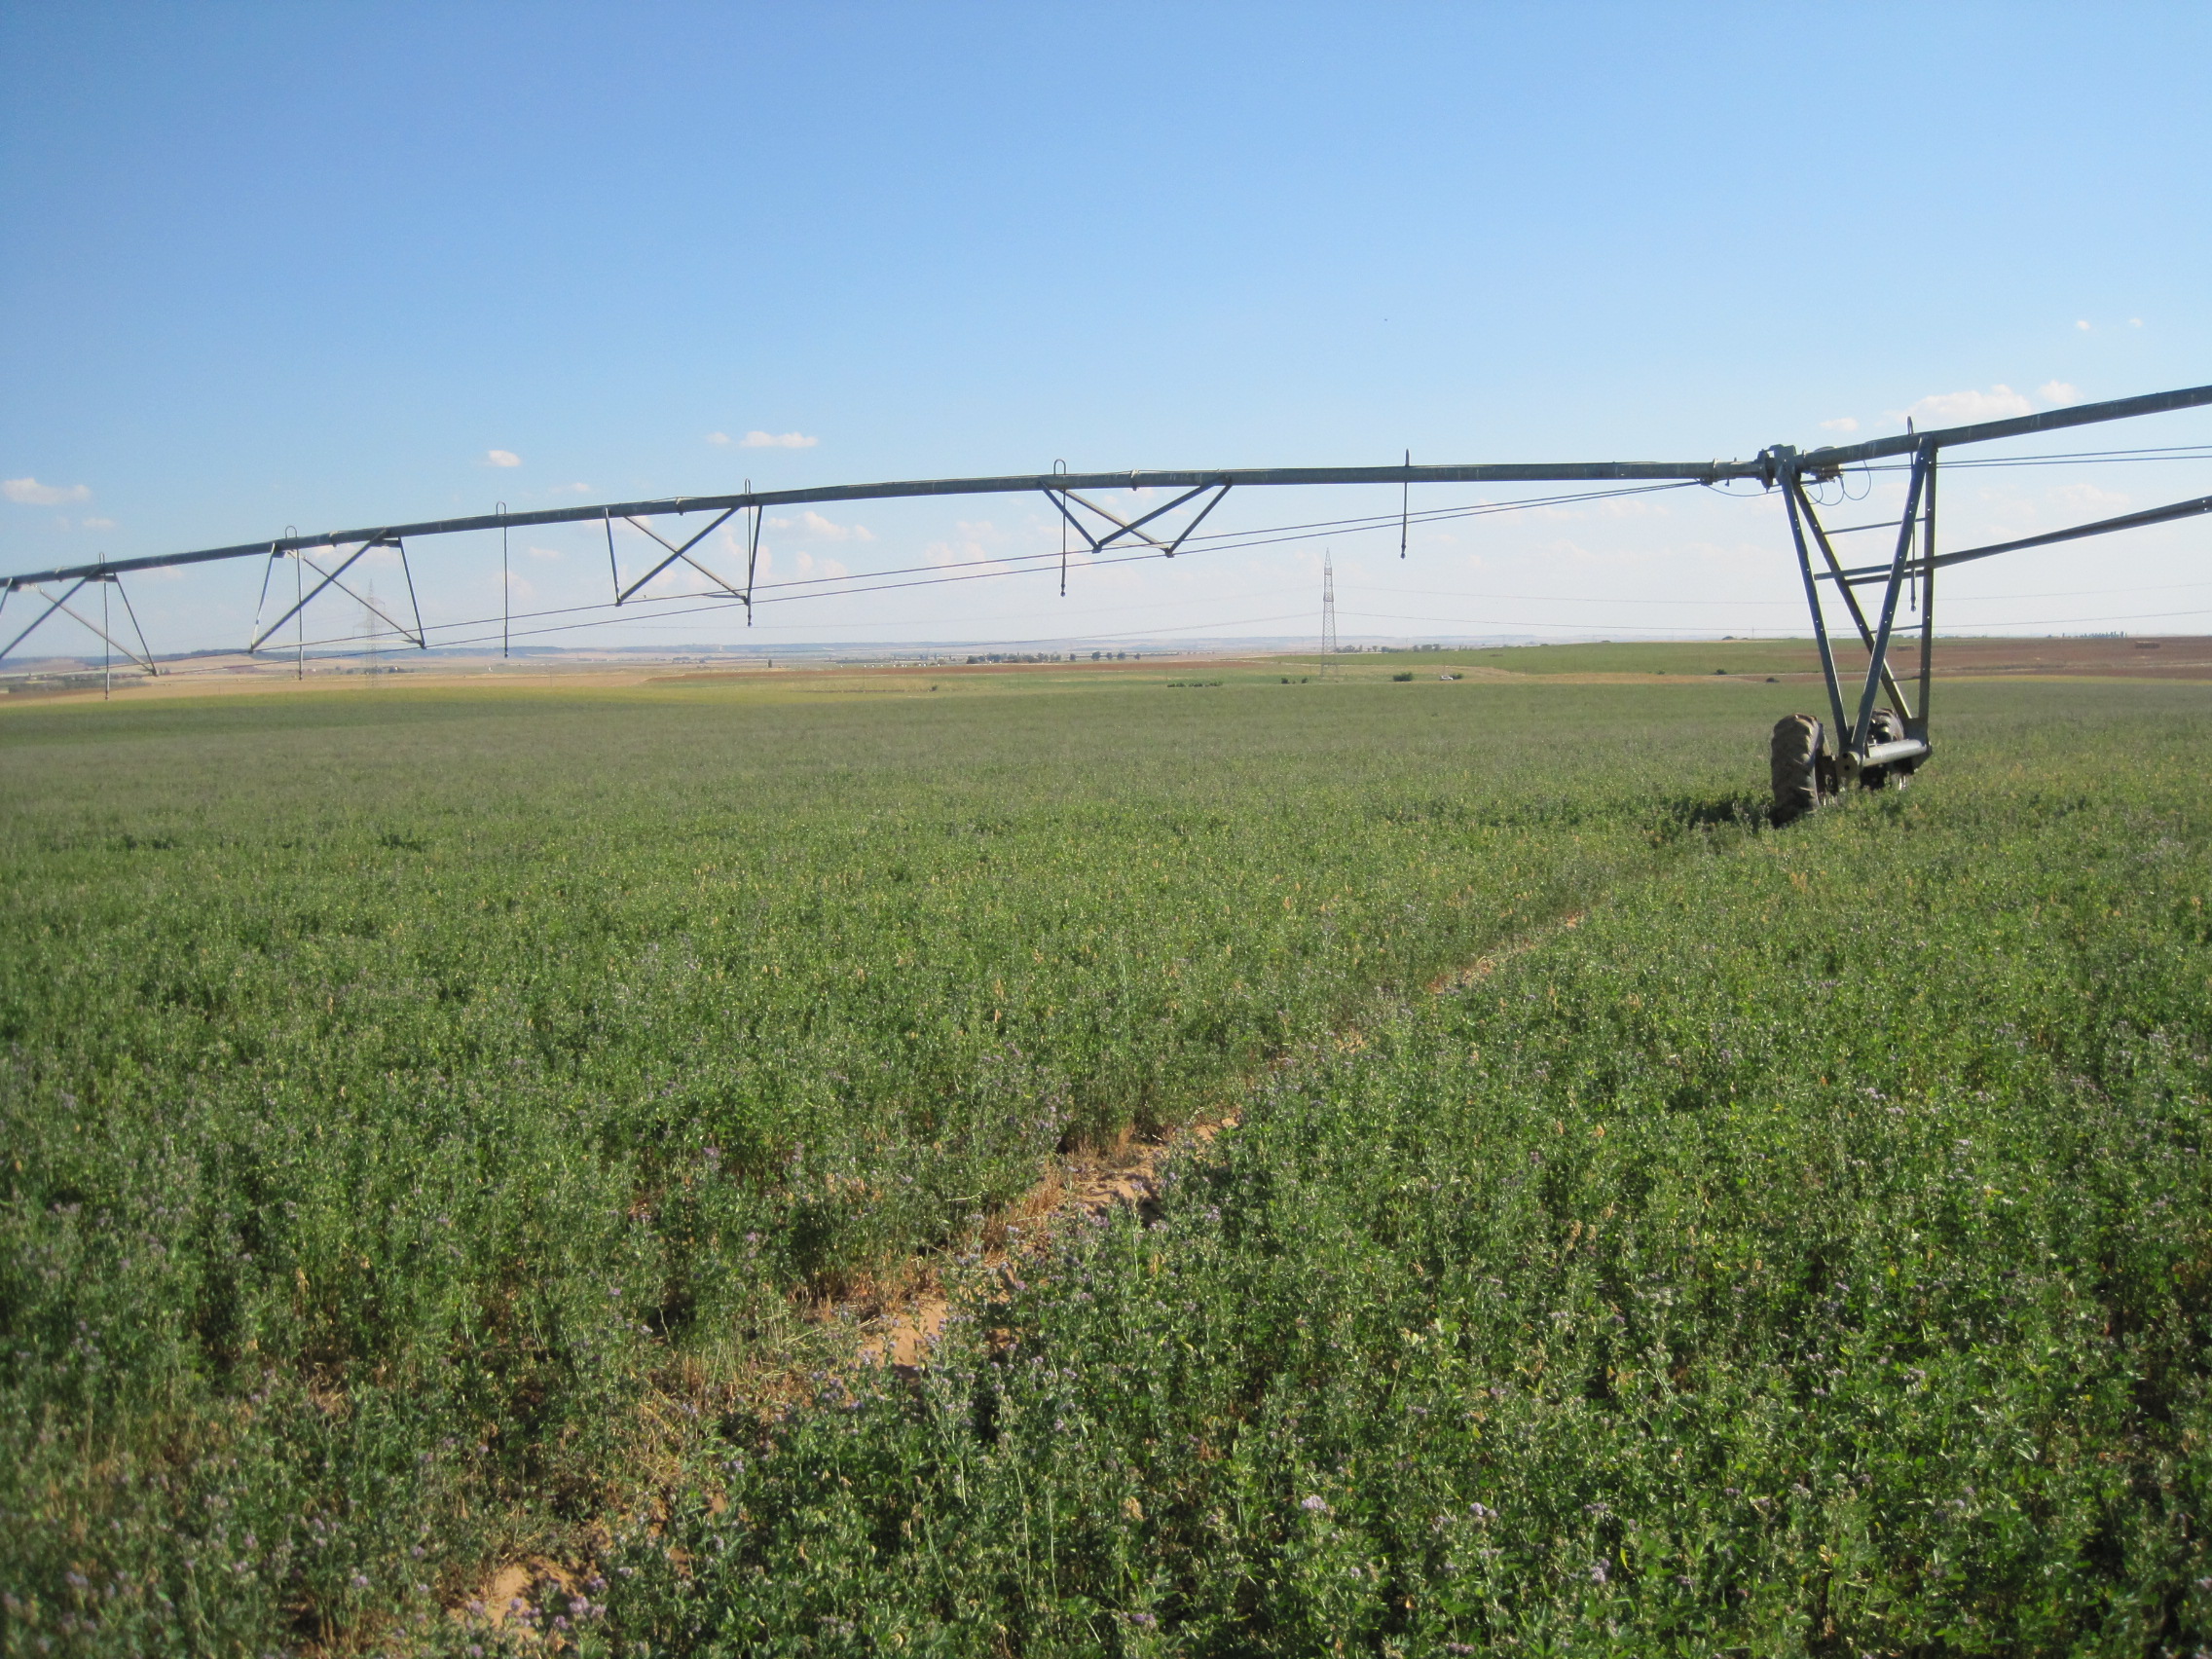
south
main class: Cropland
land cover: Lucerne
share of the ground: > 75 %
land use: Agriculture (excluding fallow land and kitchen gardens)
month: July
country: ES
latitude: 41.9049
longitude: -5.1855
